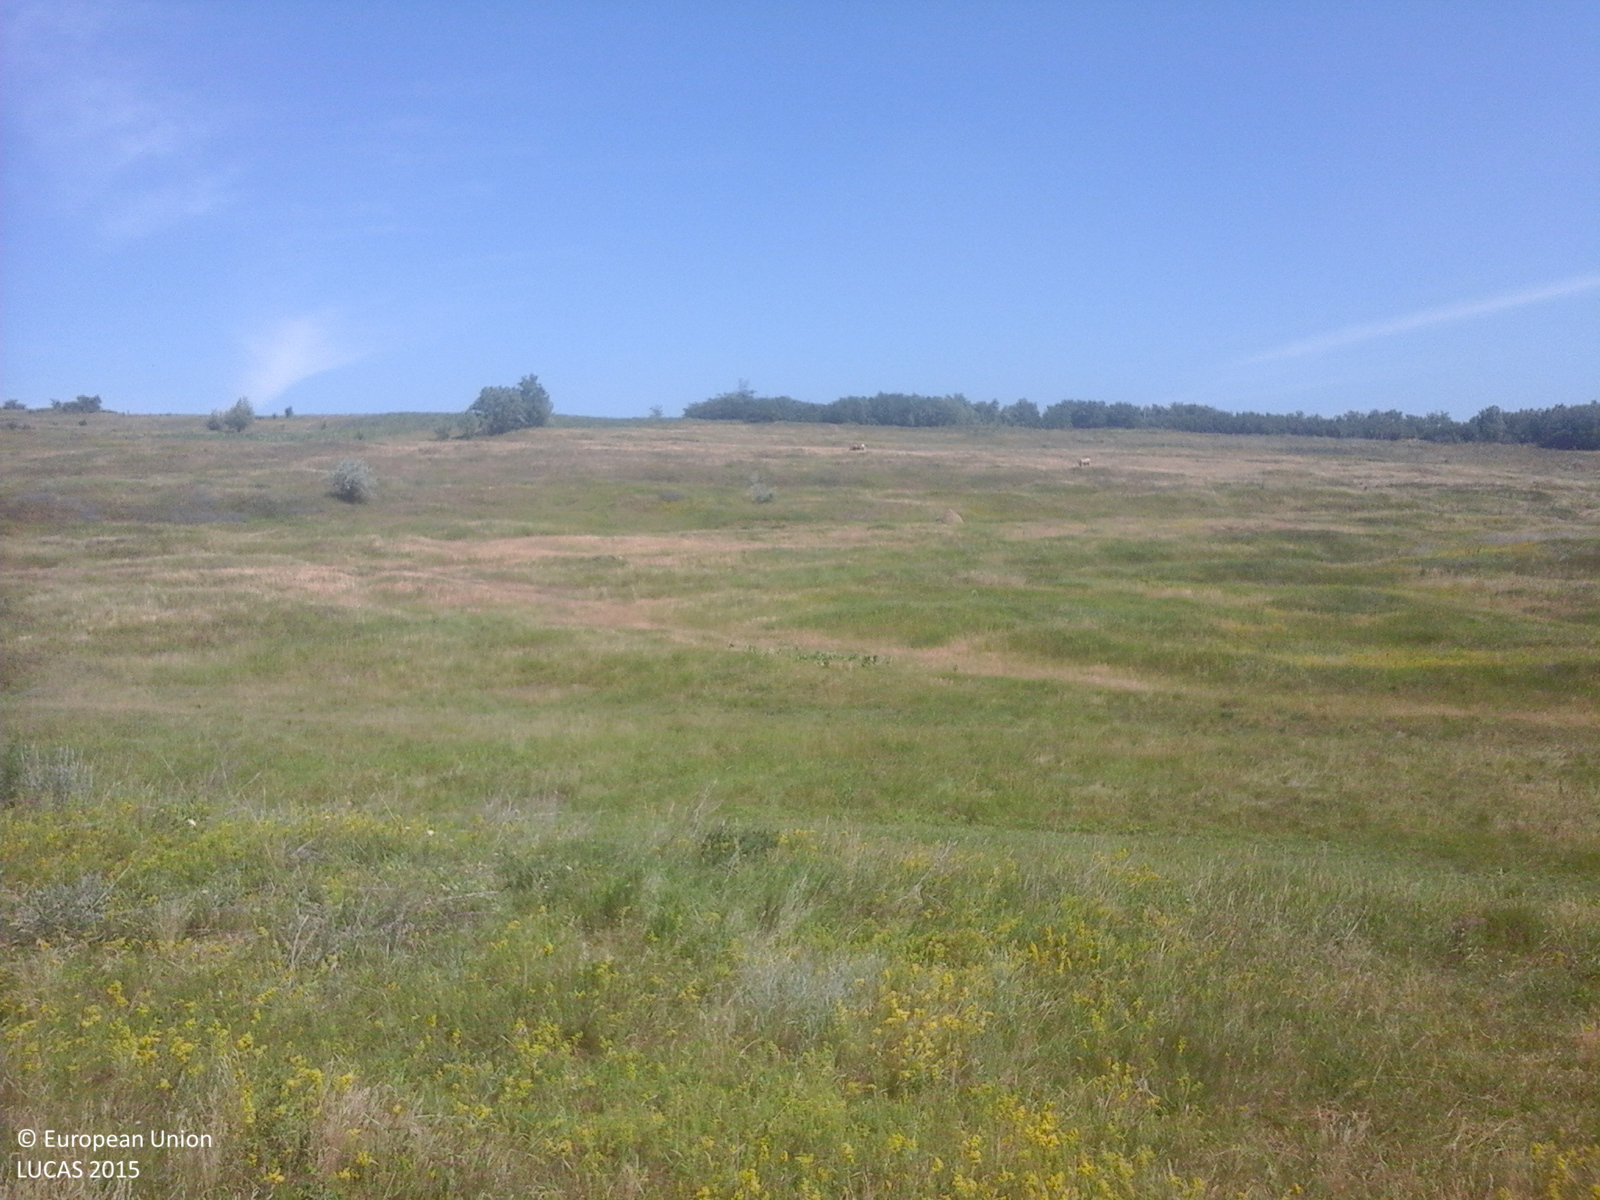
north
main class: Grassland
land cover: Grassland without tree/shrub cover
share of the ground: > 75 %
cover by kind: herbaceous plants 100 %
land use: Agriculture (excluding fallow land and kitchen gardens)
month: June
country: RO
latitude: 47.7954
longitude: 26.8552
